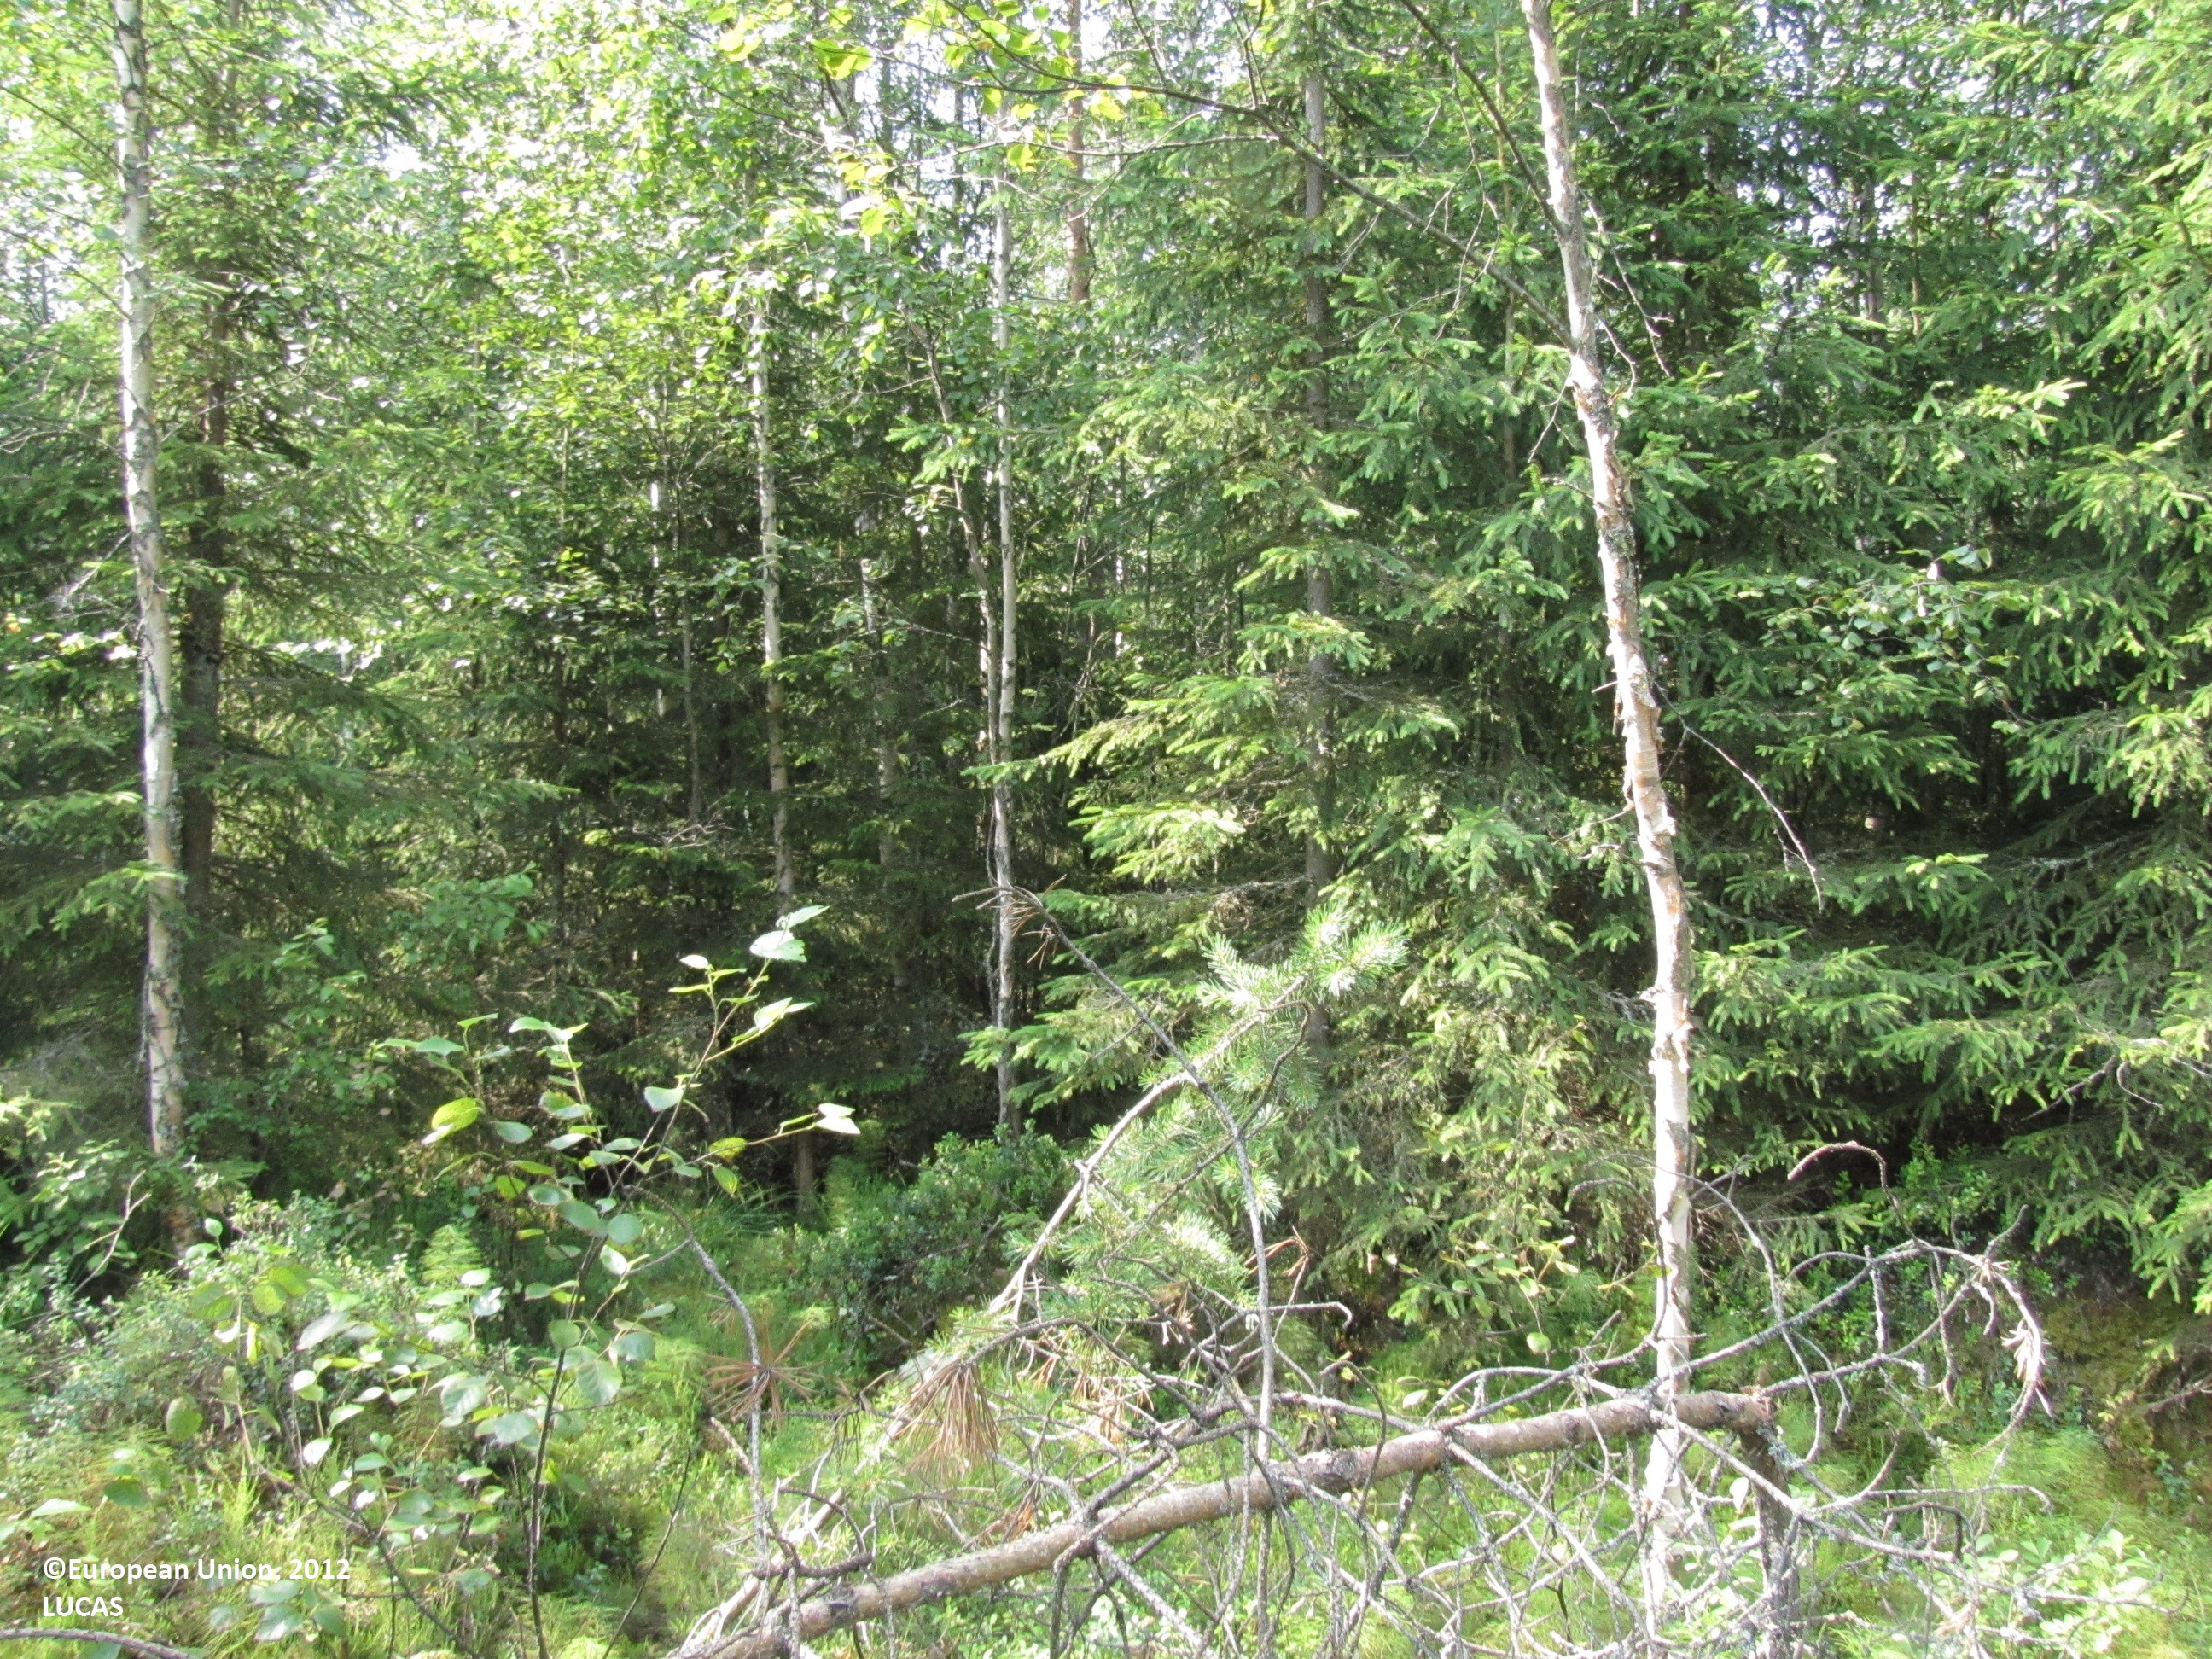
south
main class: Woodland
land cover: Other mixed woodland
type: boreal forest
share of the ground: 50 - 75 %
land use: Forestry
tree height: > 5 m
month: July
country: FI
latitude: 62.0280
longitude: 23.1996
